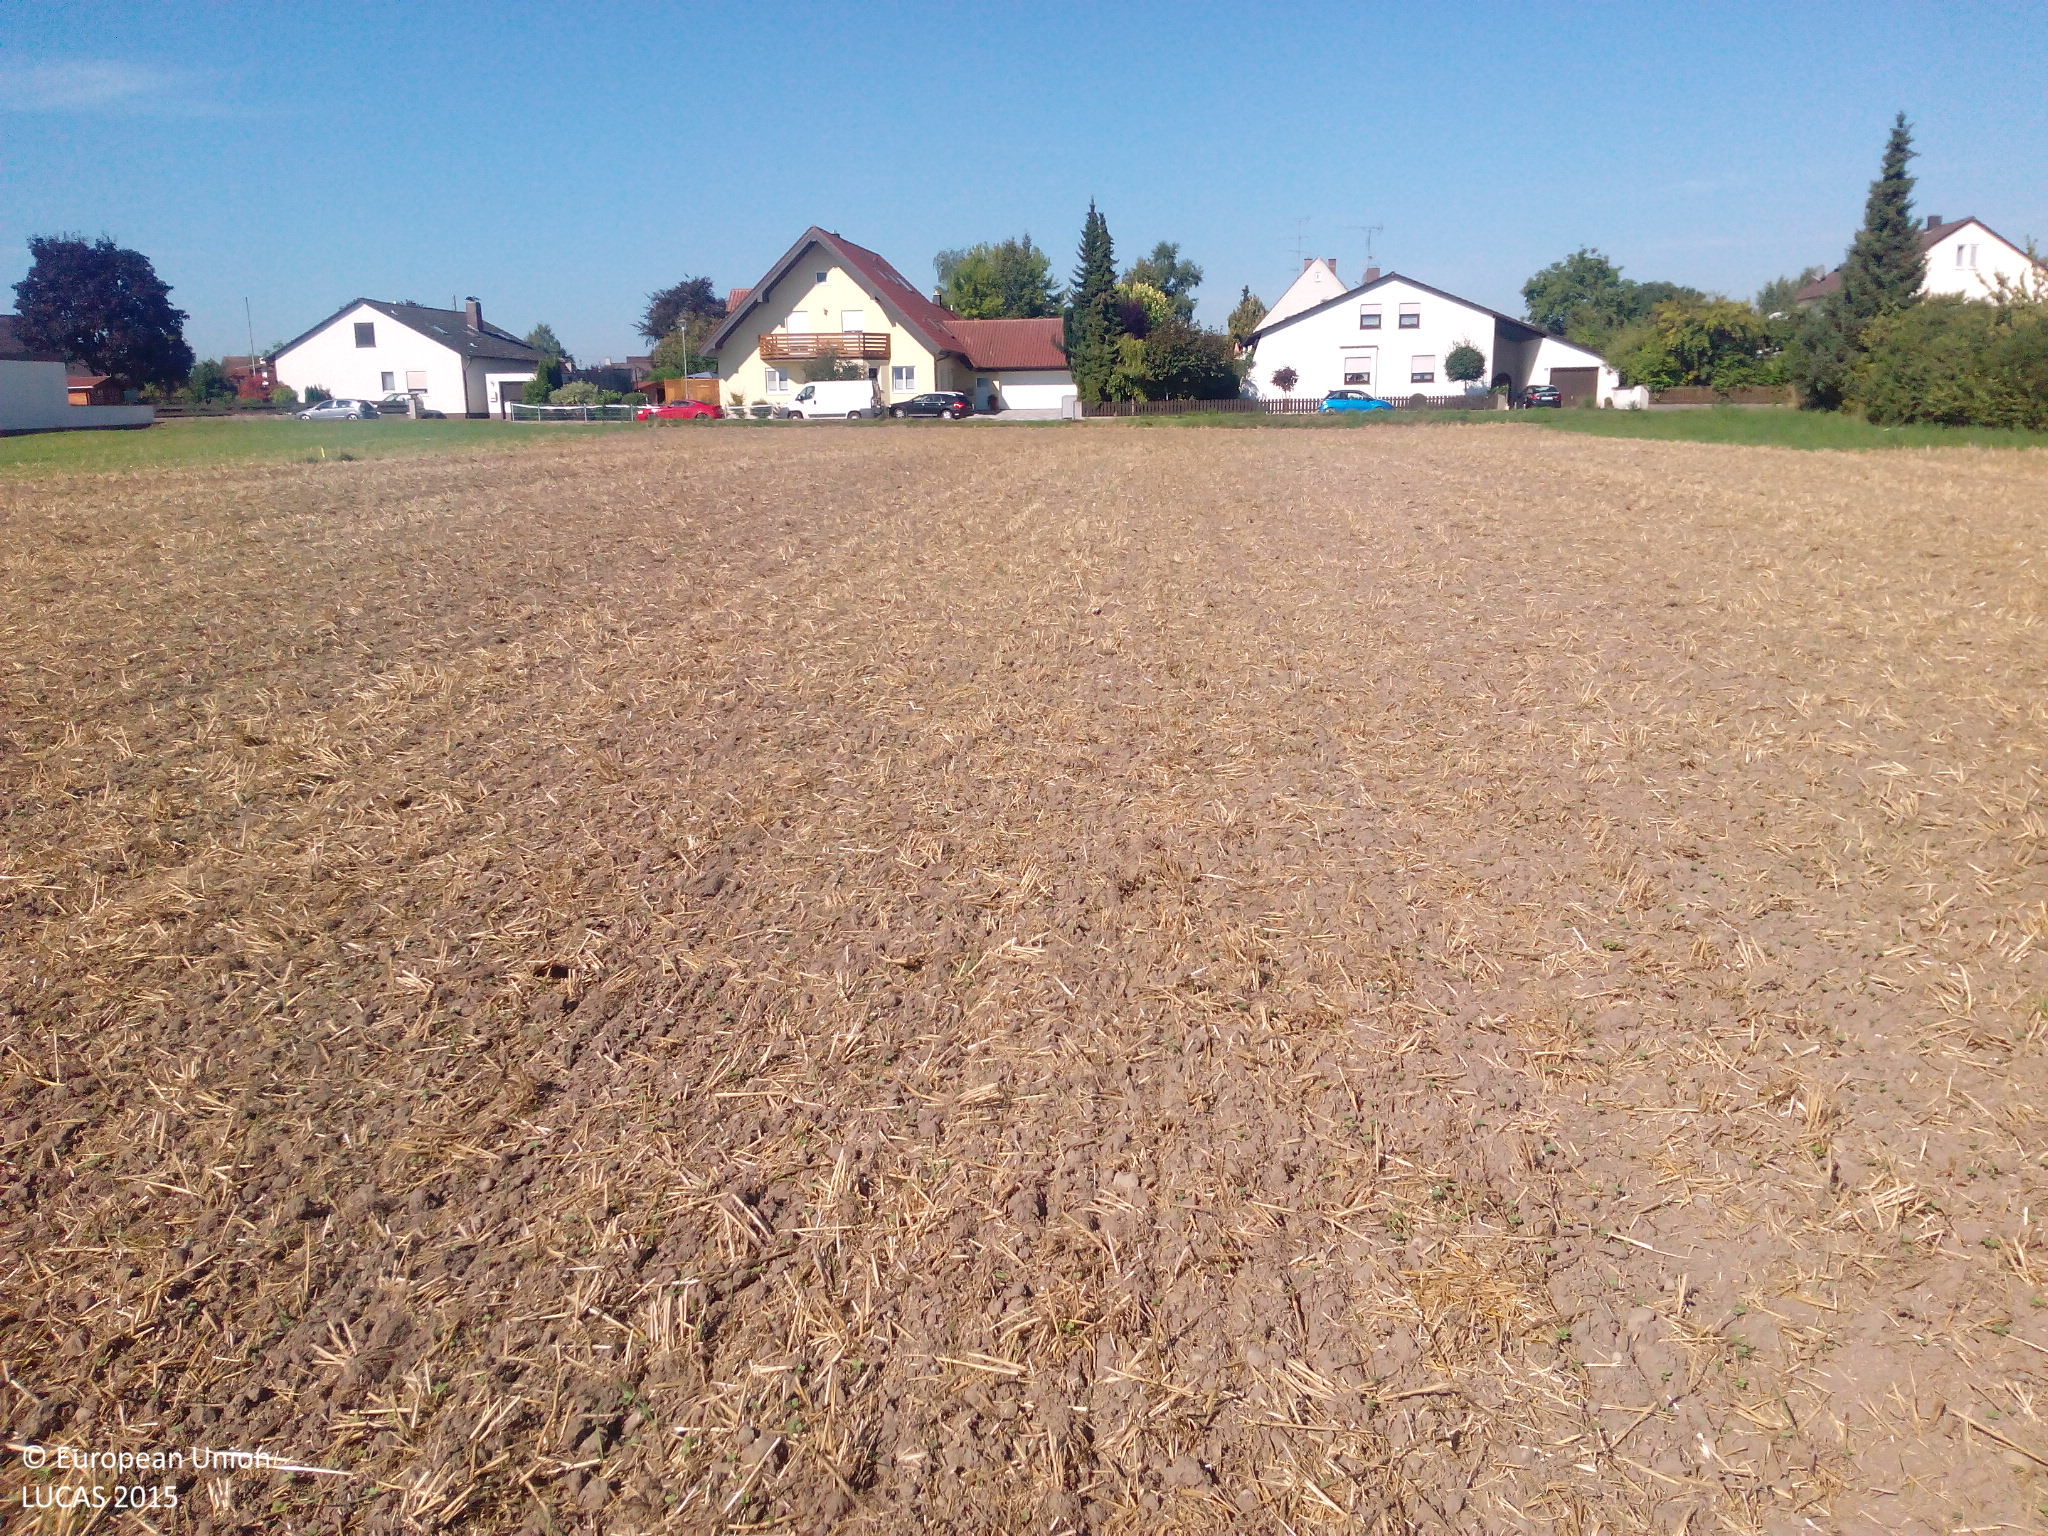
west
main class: Cropland
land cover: Rape and turnip rape
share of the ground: < 10 %
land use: Agriculture (excluding fallow land and kitchen gardens)
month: August
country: DE
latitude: 48.7058
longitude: 10.8828
